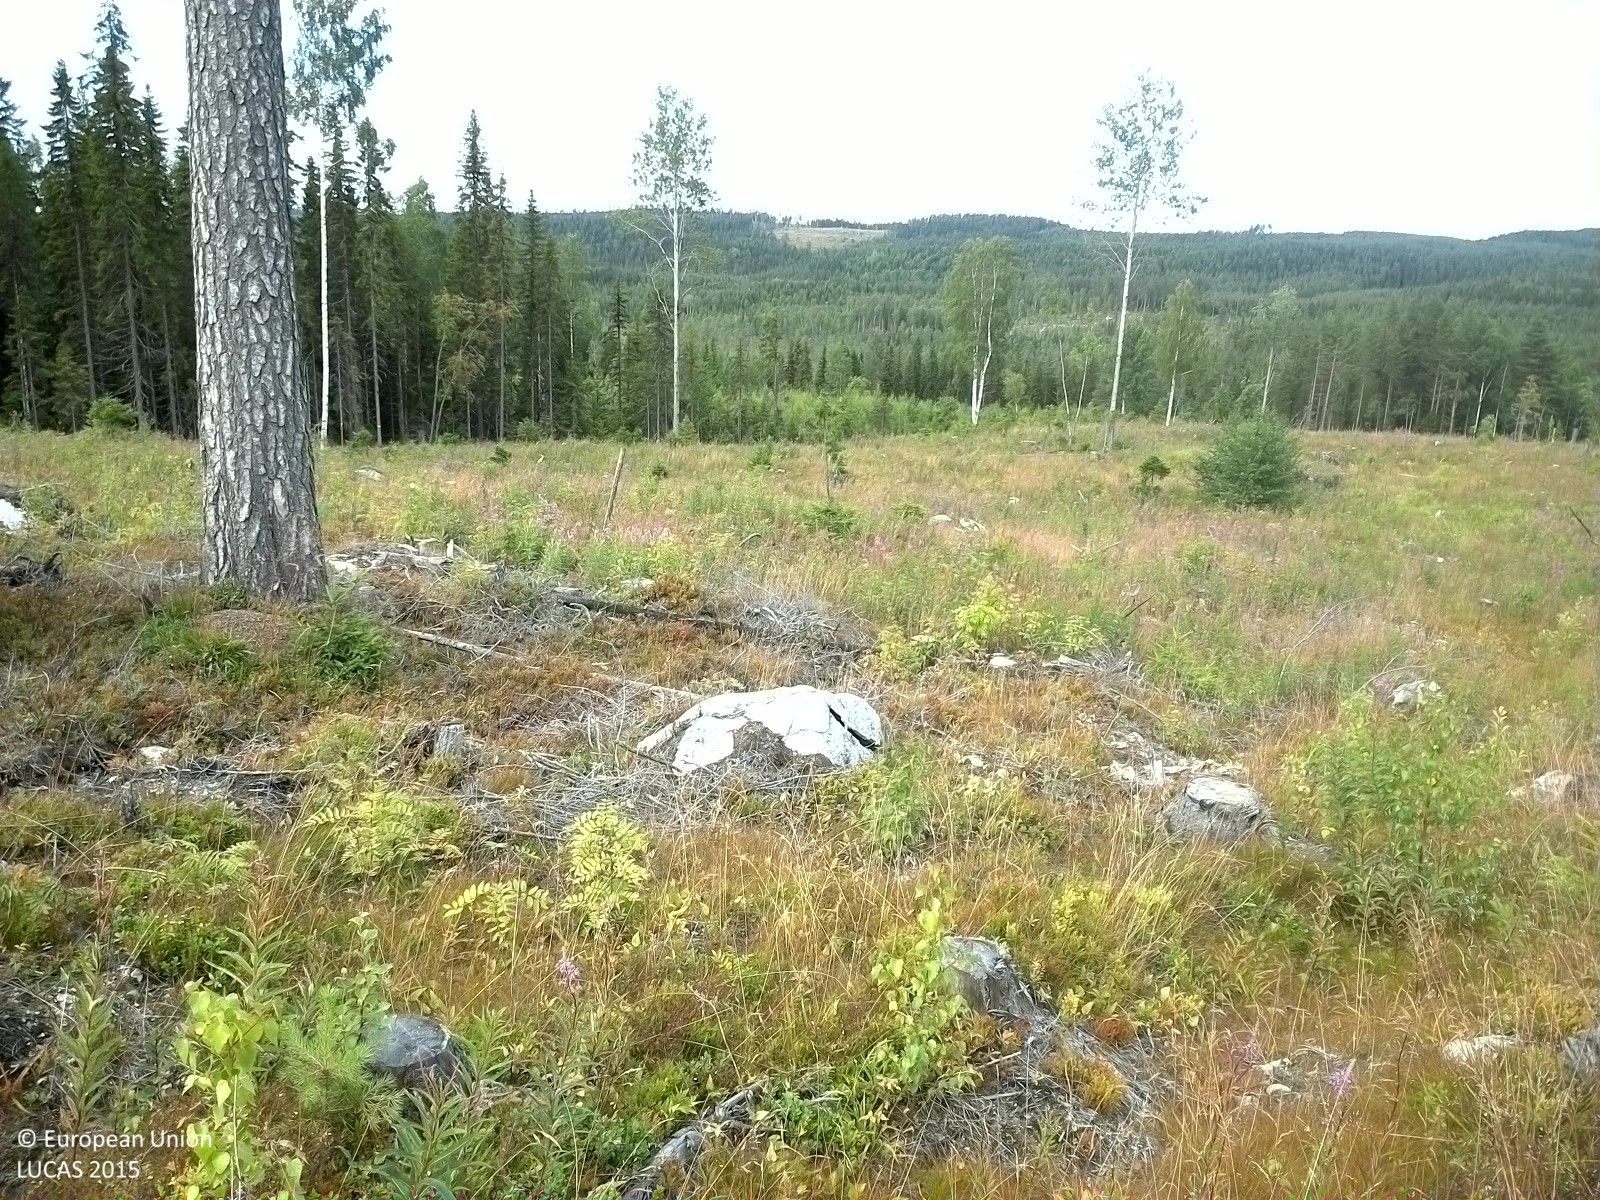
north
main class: Grassland
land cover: Grassland with sparse tree/shrub cover
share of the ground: > 75 %
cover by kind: herbaceous plants 85 %, shrubs 10 %, coniferous forest trees 5 %
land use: Forestry
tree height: < 5 m
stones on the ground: < 10 %
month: August
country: SE
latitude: 62.7266
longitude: 16.8832
